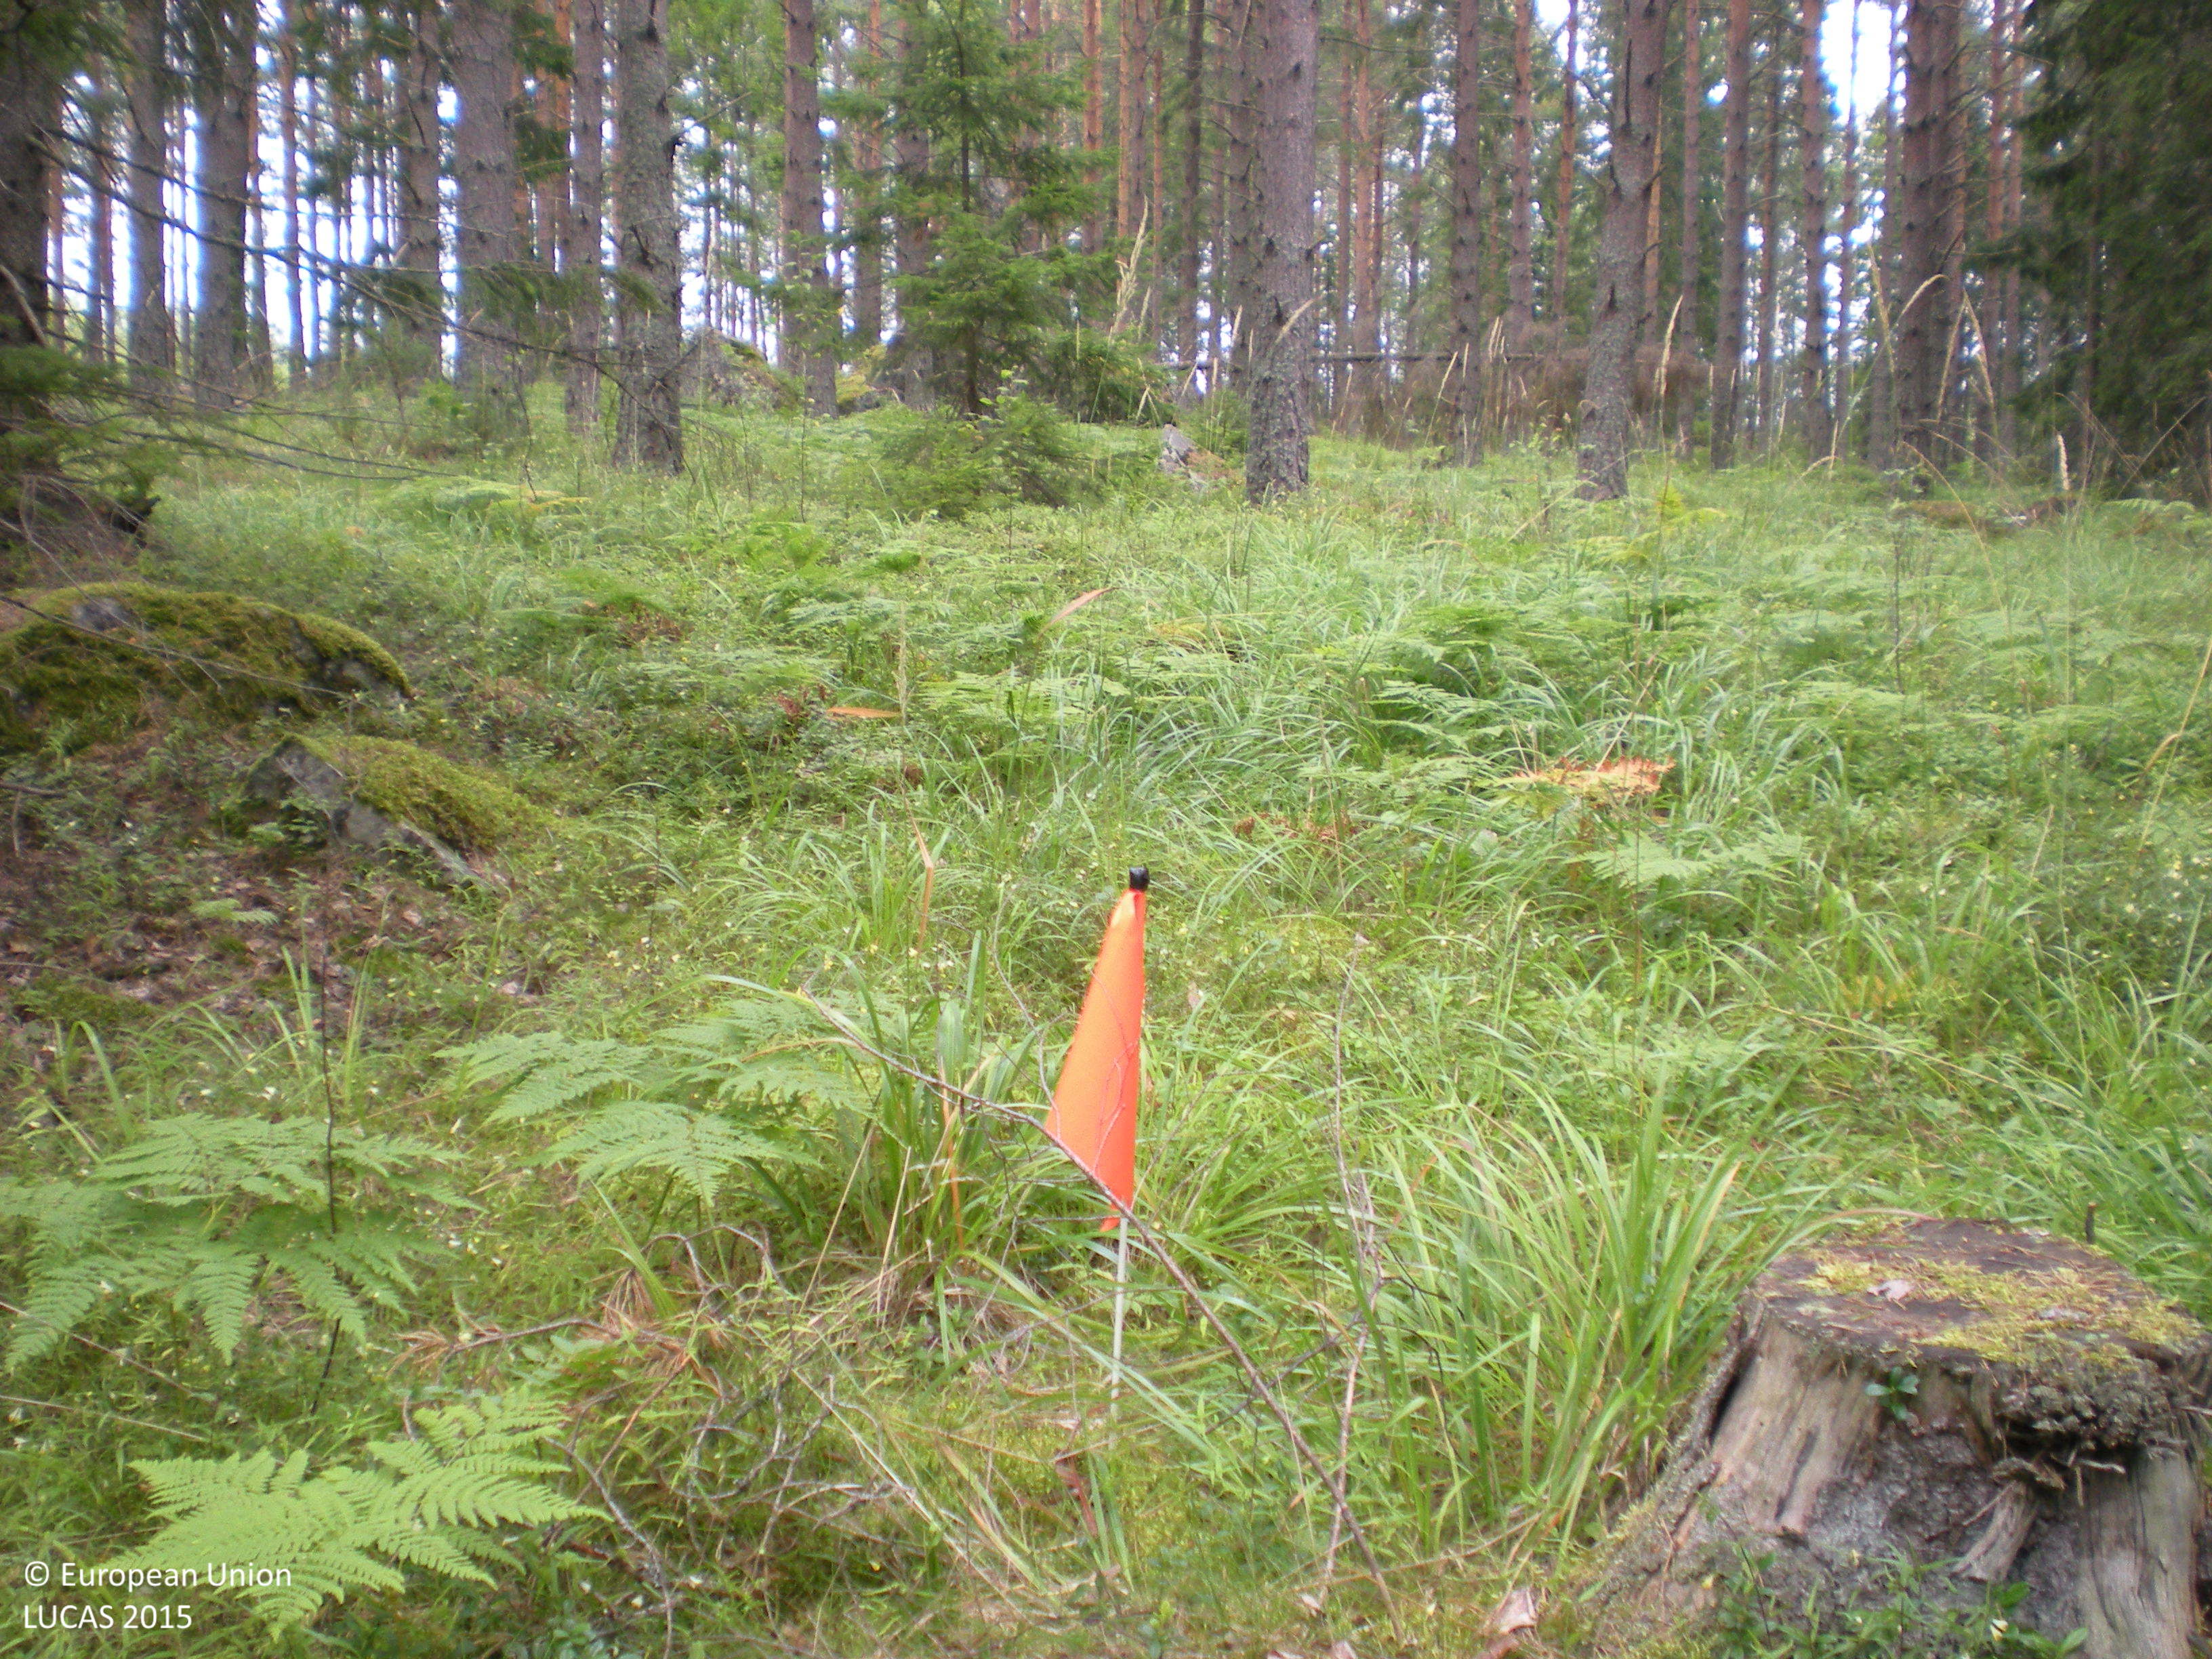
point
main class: Woodland
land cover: Pine dominated coniferous woodland
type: boreal forest
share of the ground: 50 - 75 %
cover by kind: coniferous forest trees 65 %, herbaceous plants 20 %, shrubs 10 %, lichens and mosses 5 %
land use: Forestry
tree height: > 5 m
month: August
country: SE
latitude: 60.7904
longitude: 17.2449
